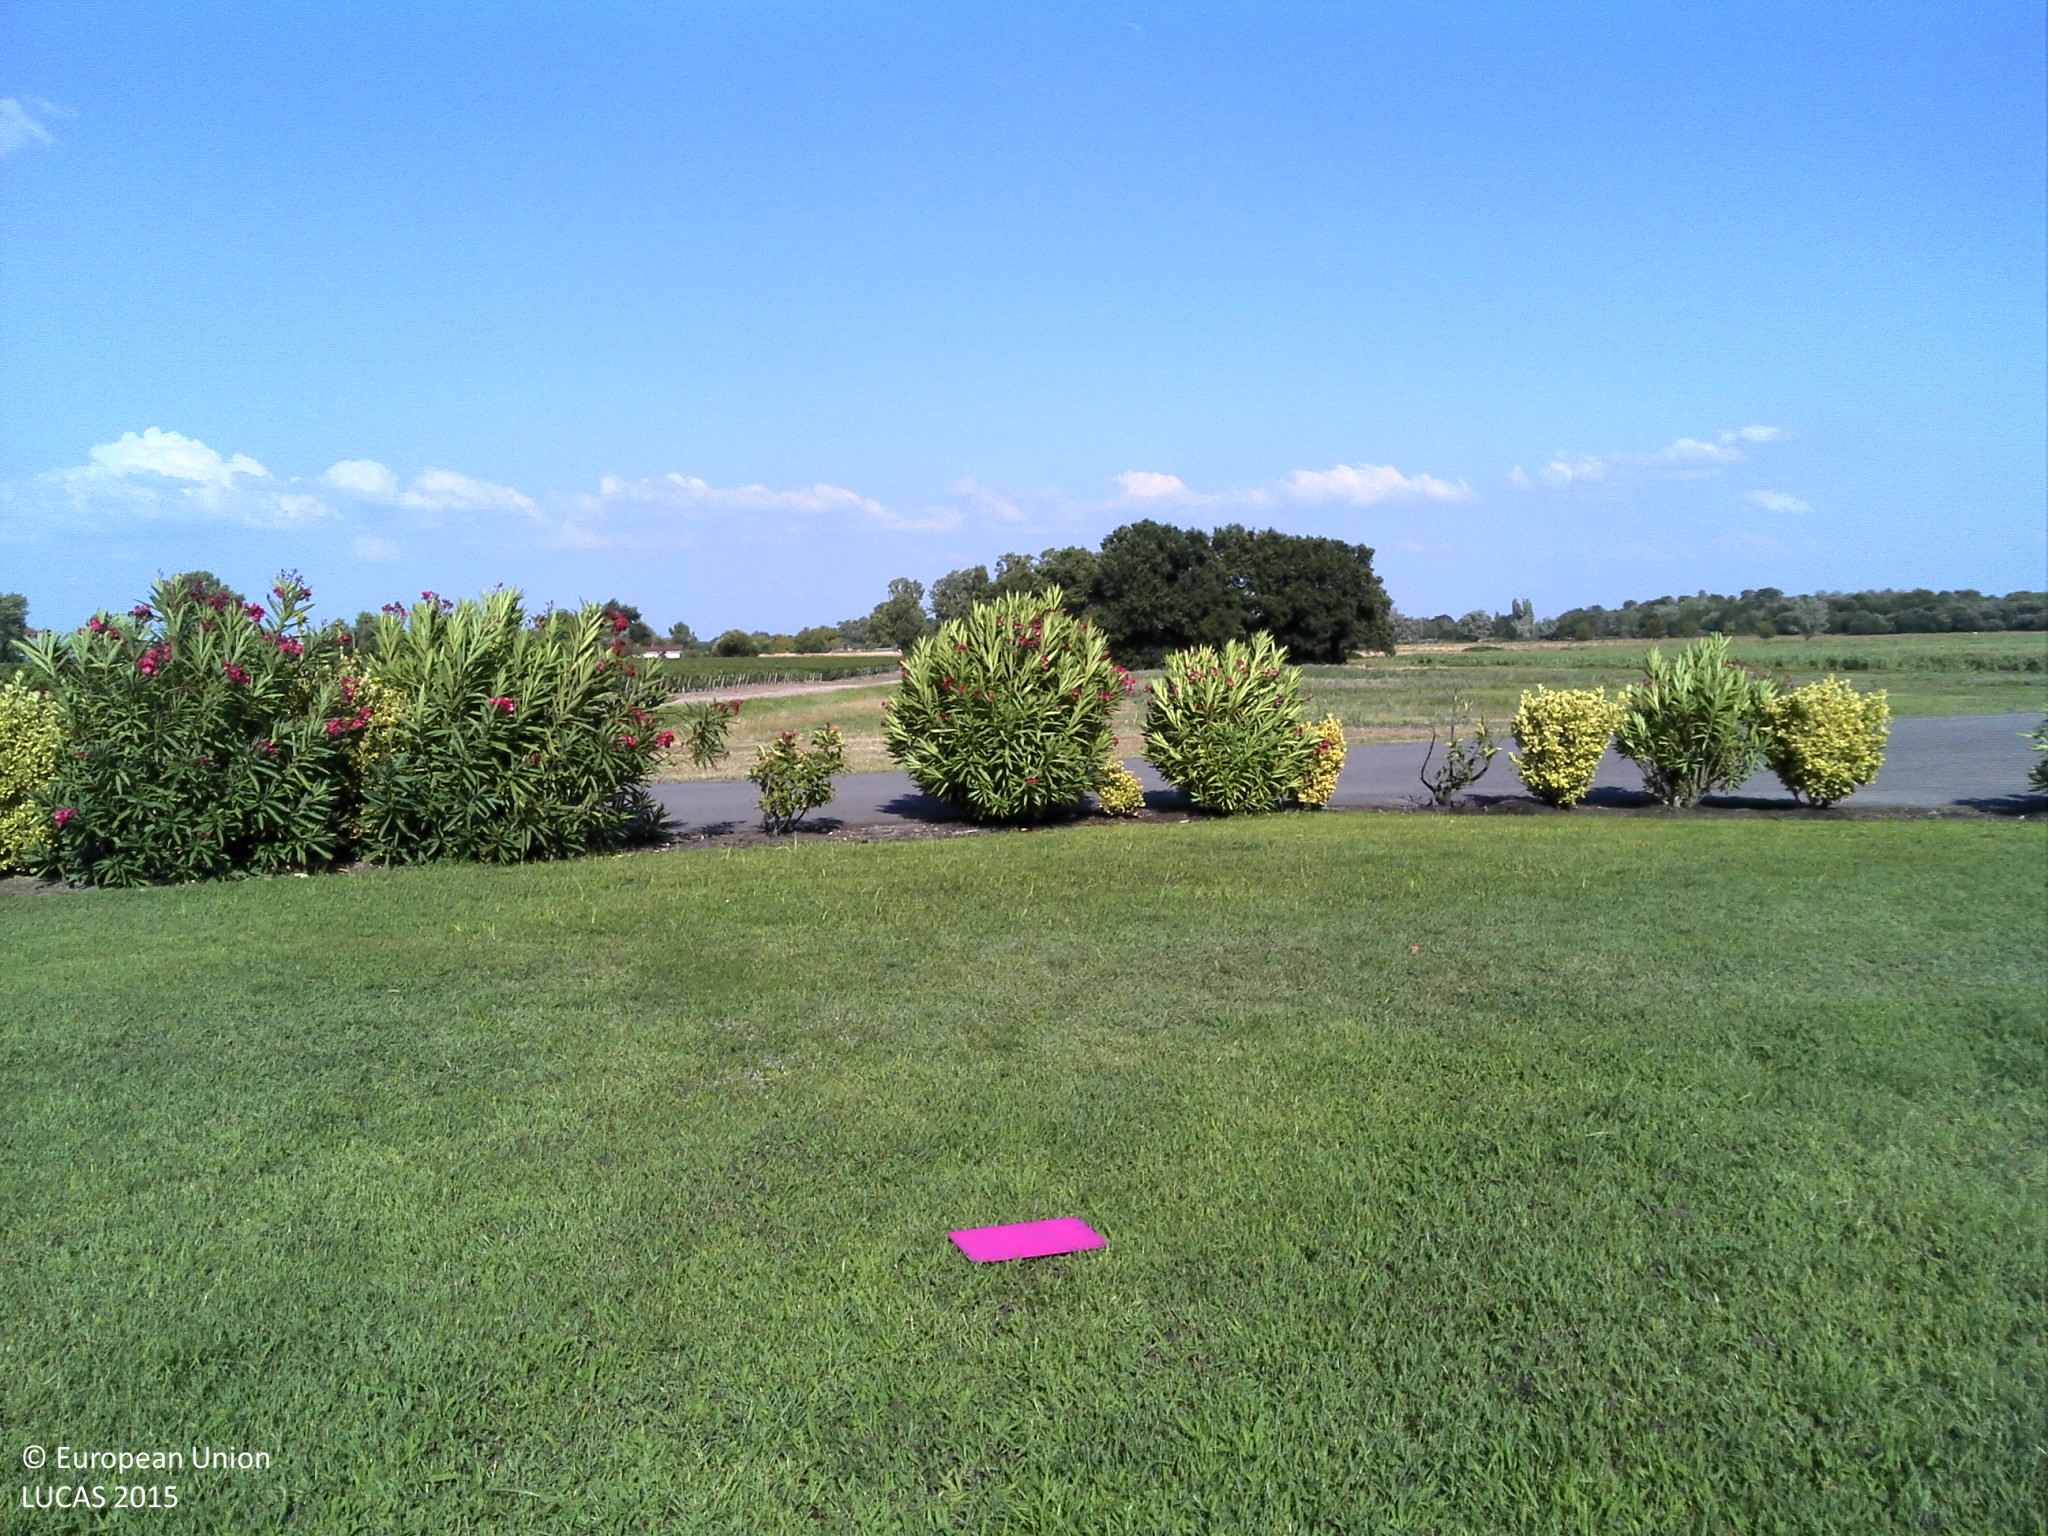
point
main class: Grassland
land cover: Grassland without tree/shrub cover
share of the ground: > 75 %
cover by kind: herbaceous plants 100 %
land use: Residential
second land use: Commerce
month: August
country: FR
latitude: 44.9686
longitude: -0.6065
